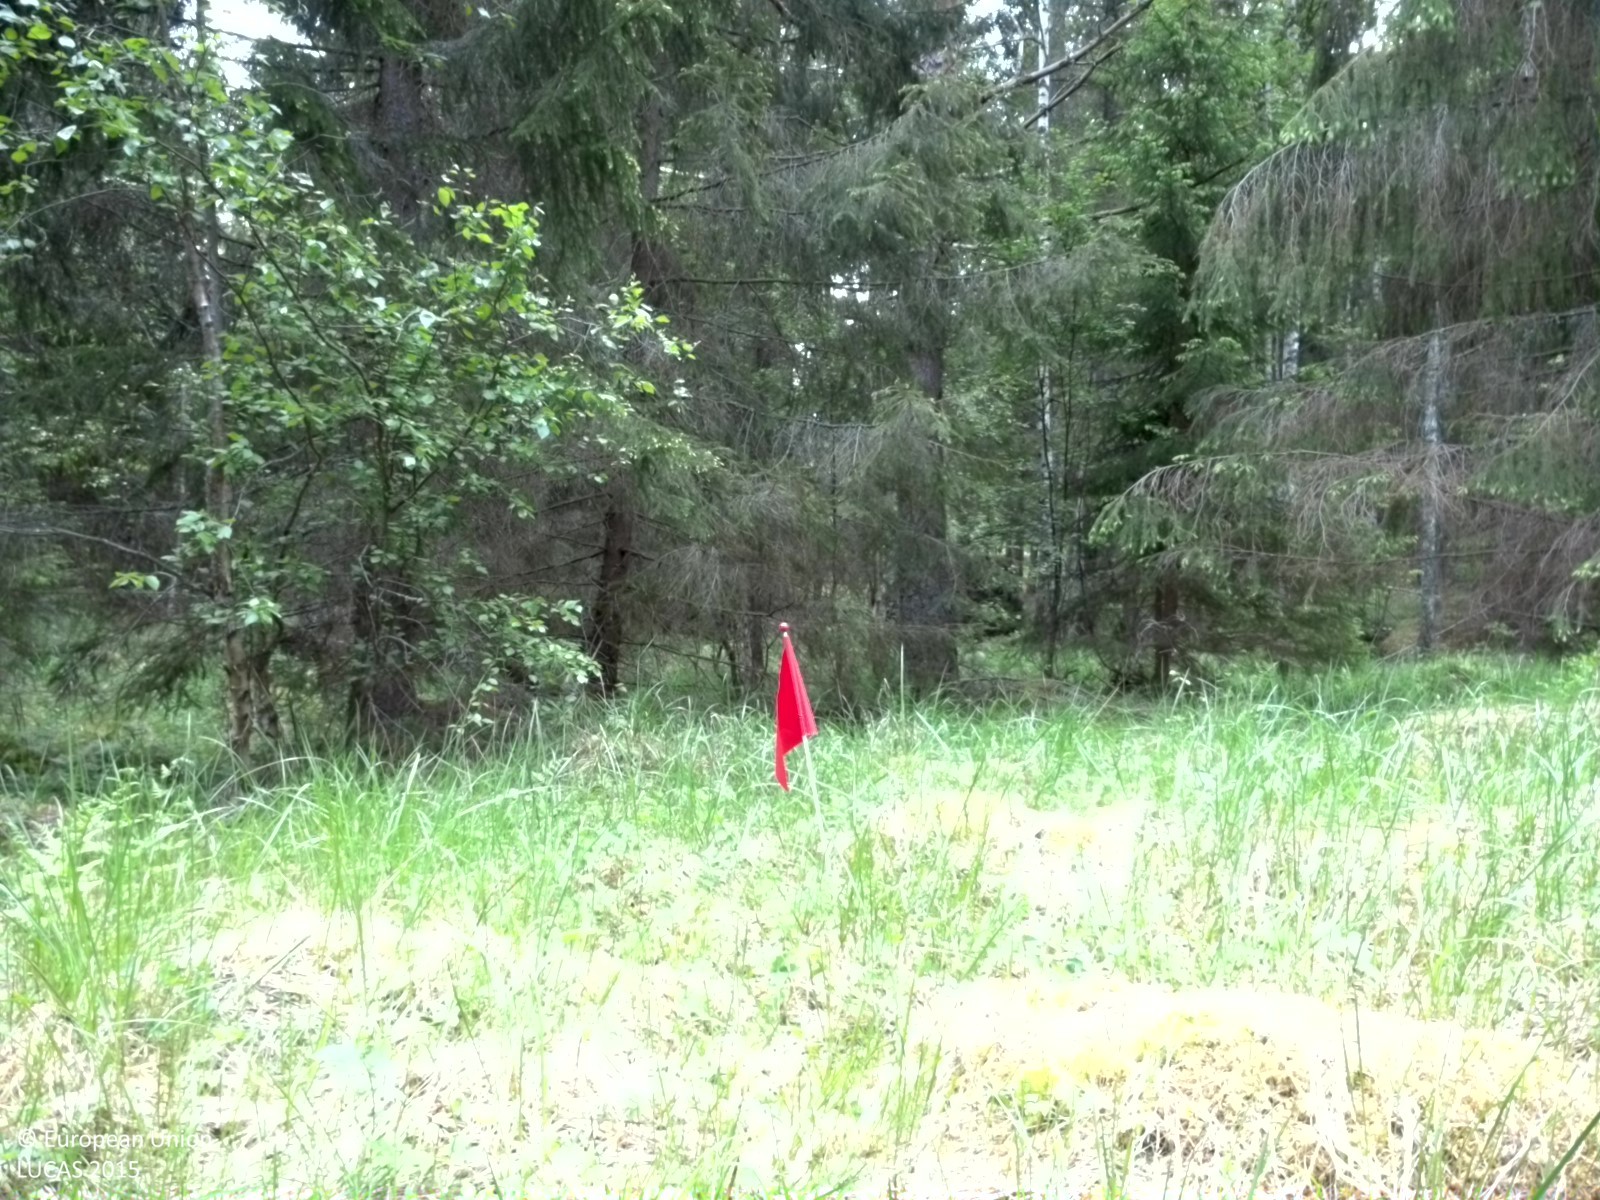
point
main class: Woodland
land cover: Spruce dominated coniferous woodland
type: boreal forest
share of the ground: 50 - 75 %
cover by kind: coniferous forest trees 45 %, herbaceous plants 20 %, broadleaved forest trees 15 %, shrubs 5 %, lichens and mosses 5 %
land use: Forestry
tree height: > 5 m
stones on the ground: 10 - 25 %
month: June
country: SE
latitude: 60.2912
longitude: 17.0998
